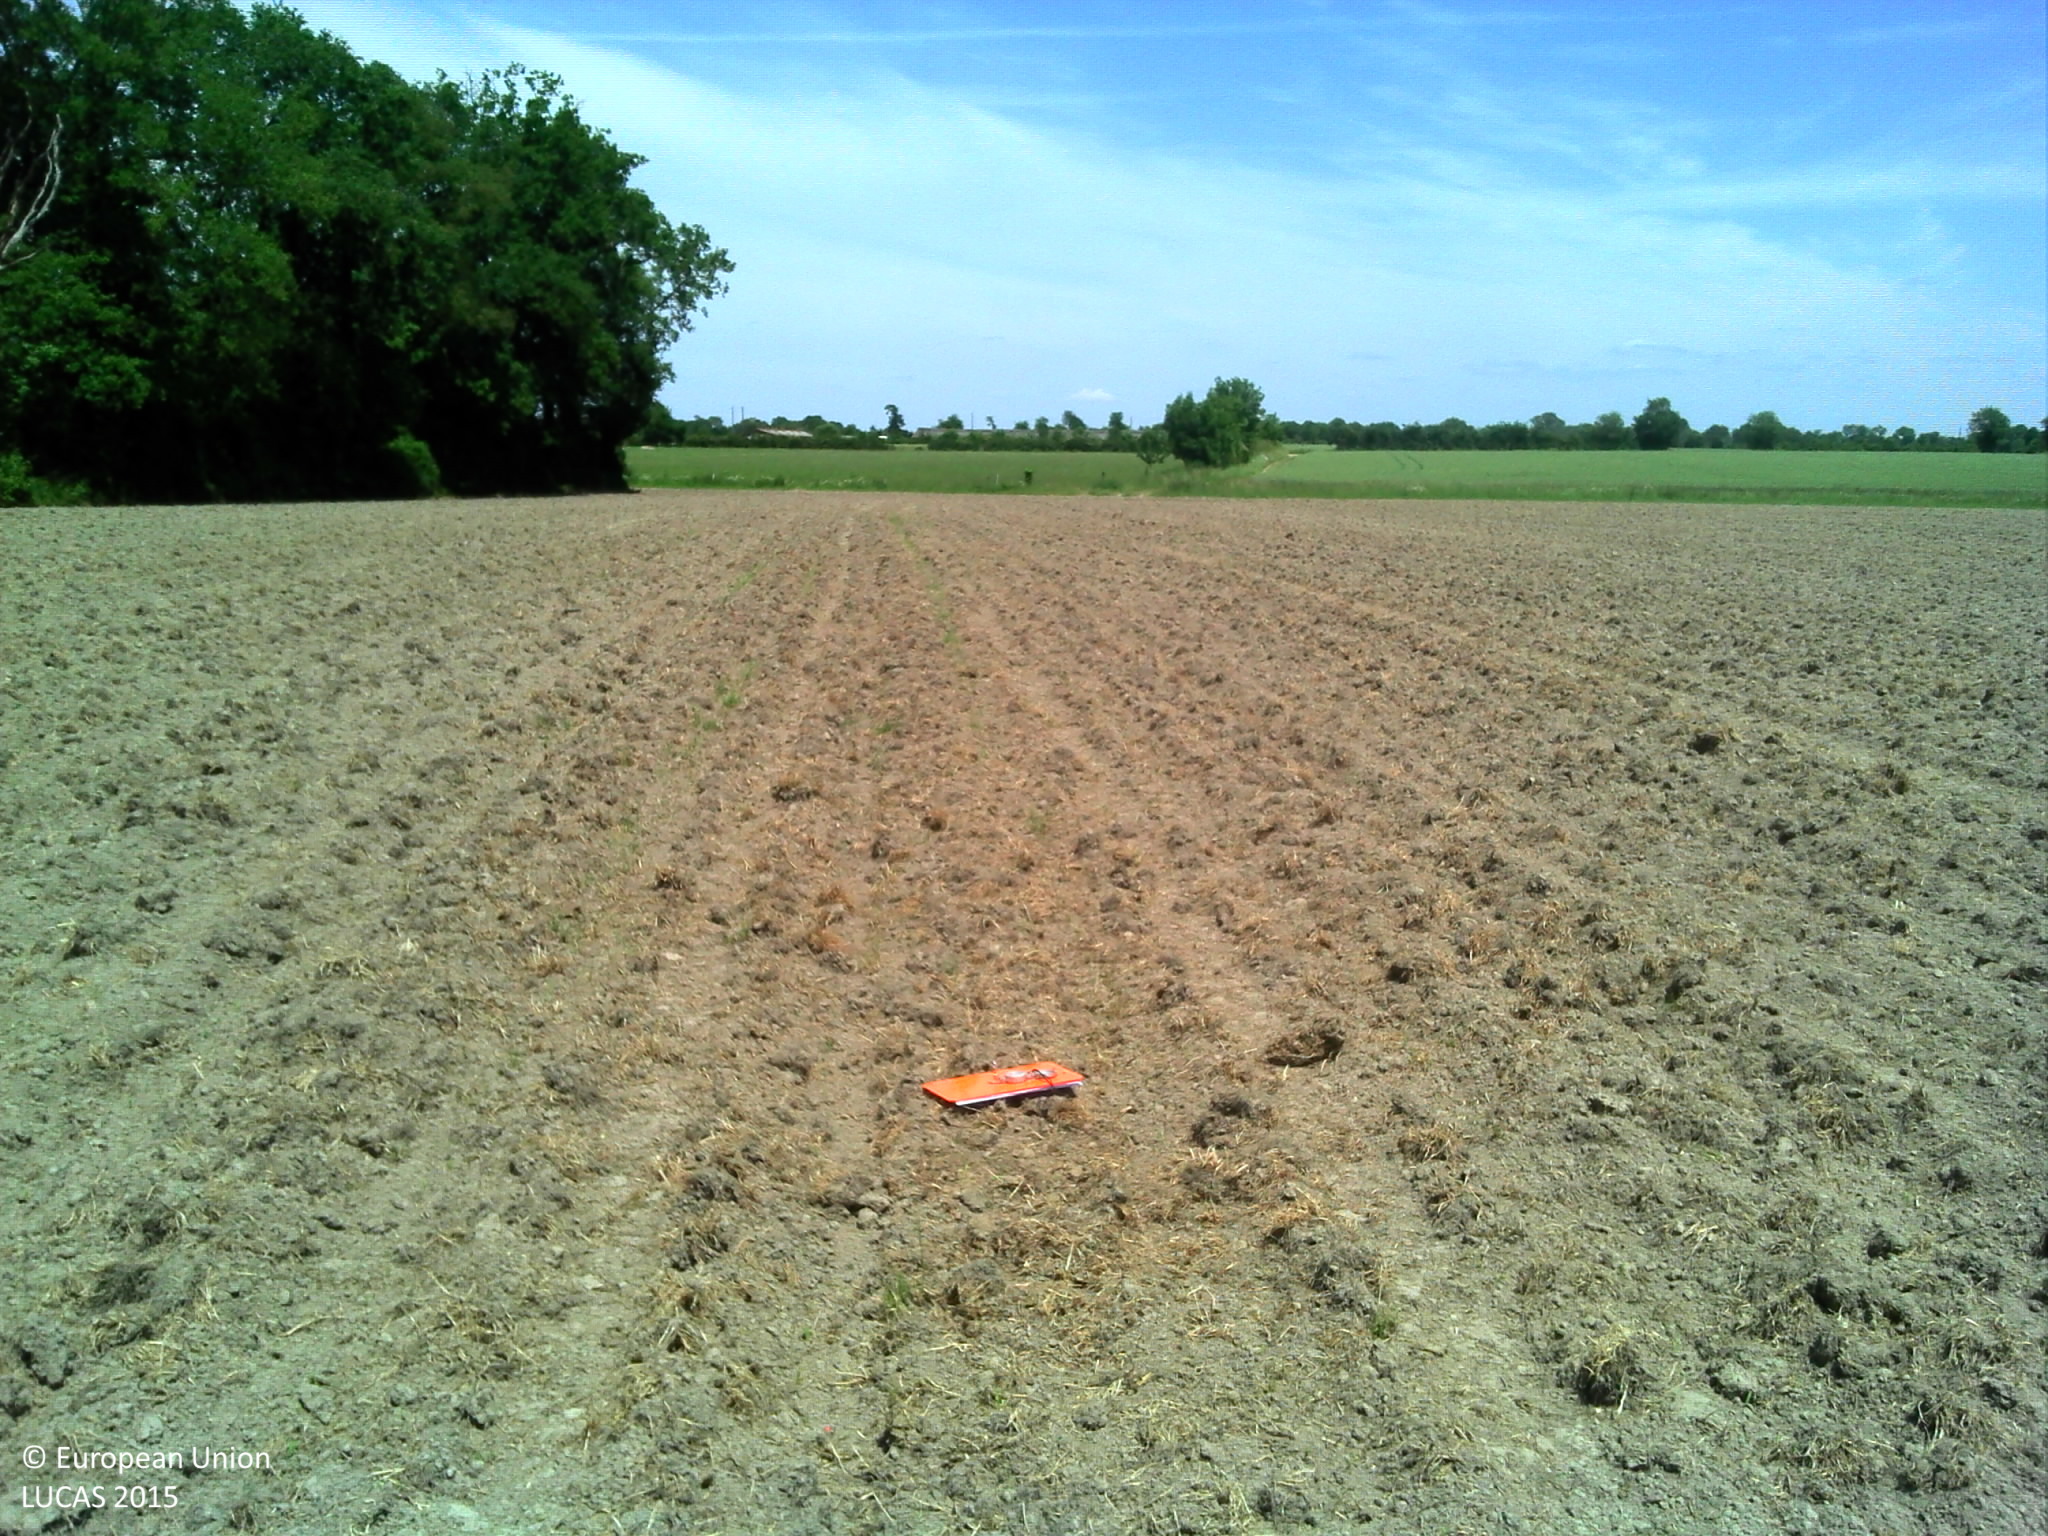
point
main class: Cropland
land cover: Maize
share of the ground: < 10 %
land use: Agriculture (excluding fallow land and kitchen gardens)
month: May
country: FR
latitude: 47.0117
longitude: -1.2312
